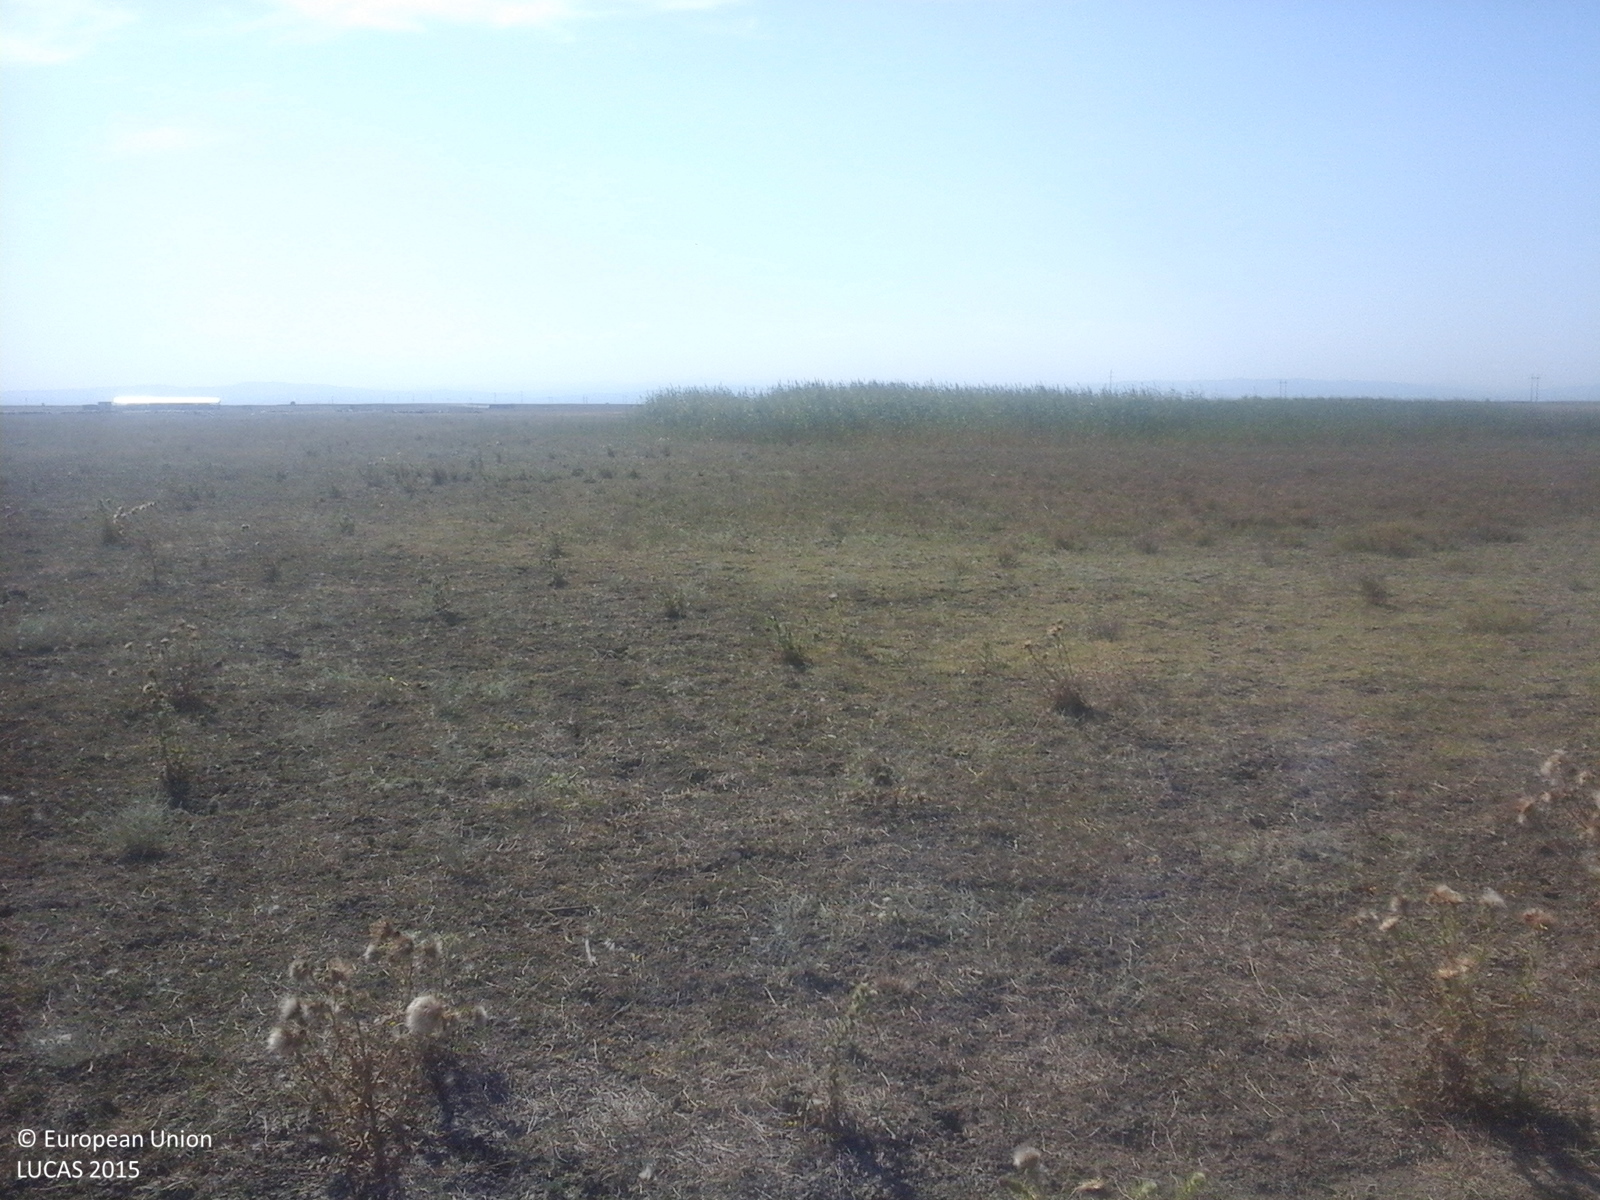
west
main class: Grassland
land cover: Grassland without tree/shrub cover
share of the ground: 50 - 75 %
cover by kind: herbaceous plants 100 %
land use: Agriculture (excluding fallow land and kitchen gardens)
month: August
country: RO
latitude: 45.5716
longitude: 27.4119
